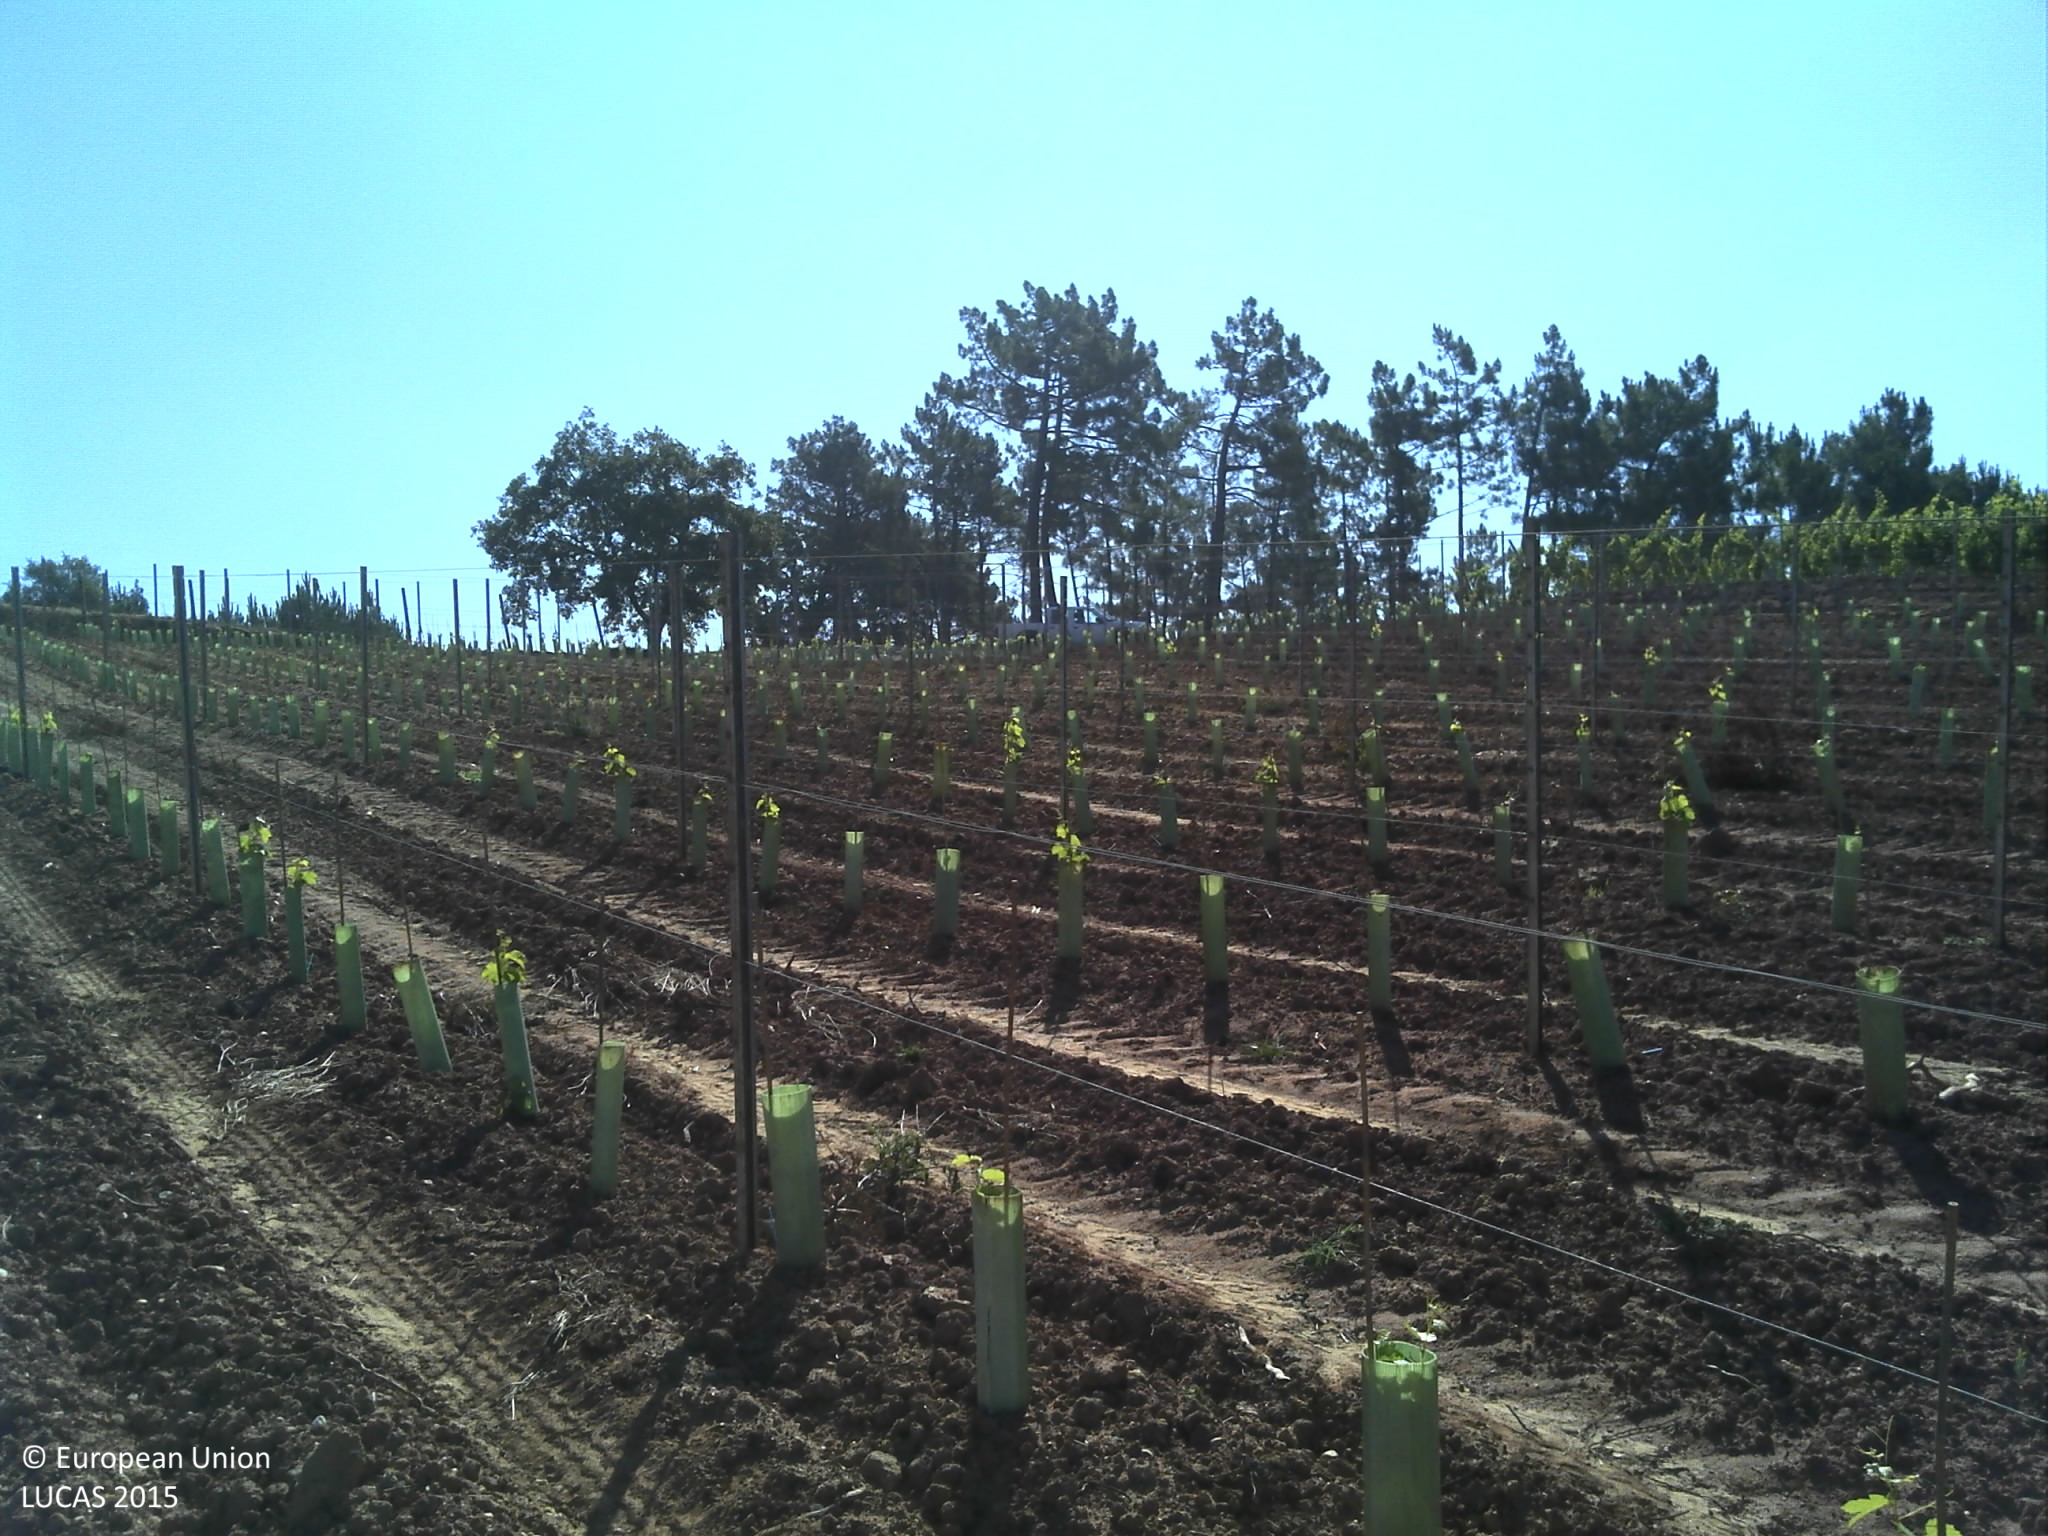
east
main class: Cropland
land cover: Vineyards
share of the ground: < 10 %
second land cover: Other bare soil
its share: > 75 %
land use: Agriculture (excluding fallow land and kitchen gardens)
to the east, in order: Vineyards; Other bare soil; Vineyards; Tracks; Pine dominated coniferous woodland; Tracks; Vineyards; Tracks; Grassland without tree/shrub cover
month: June
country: PT
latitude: 39.1059
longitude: -9.2238
